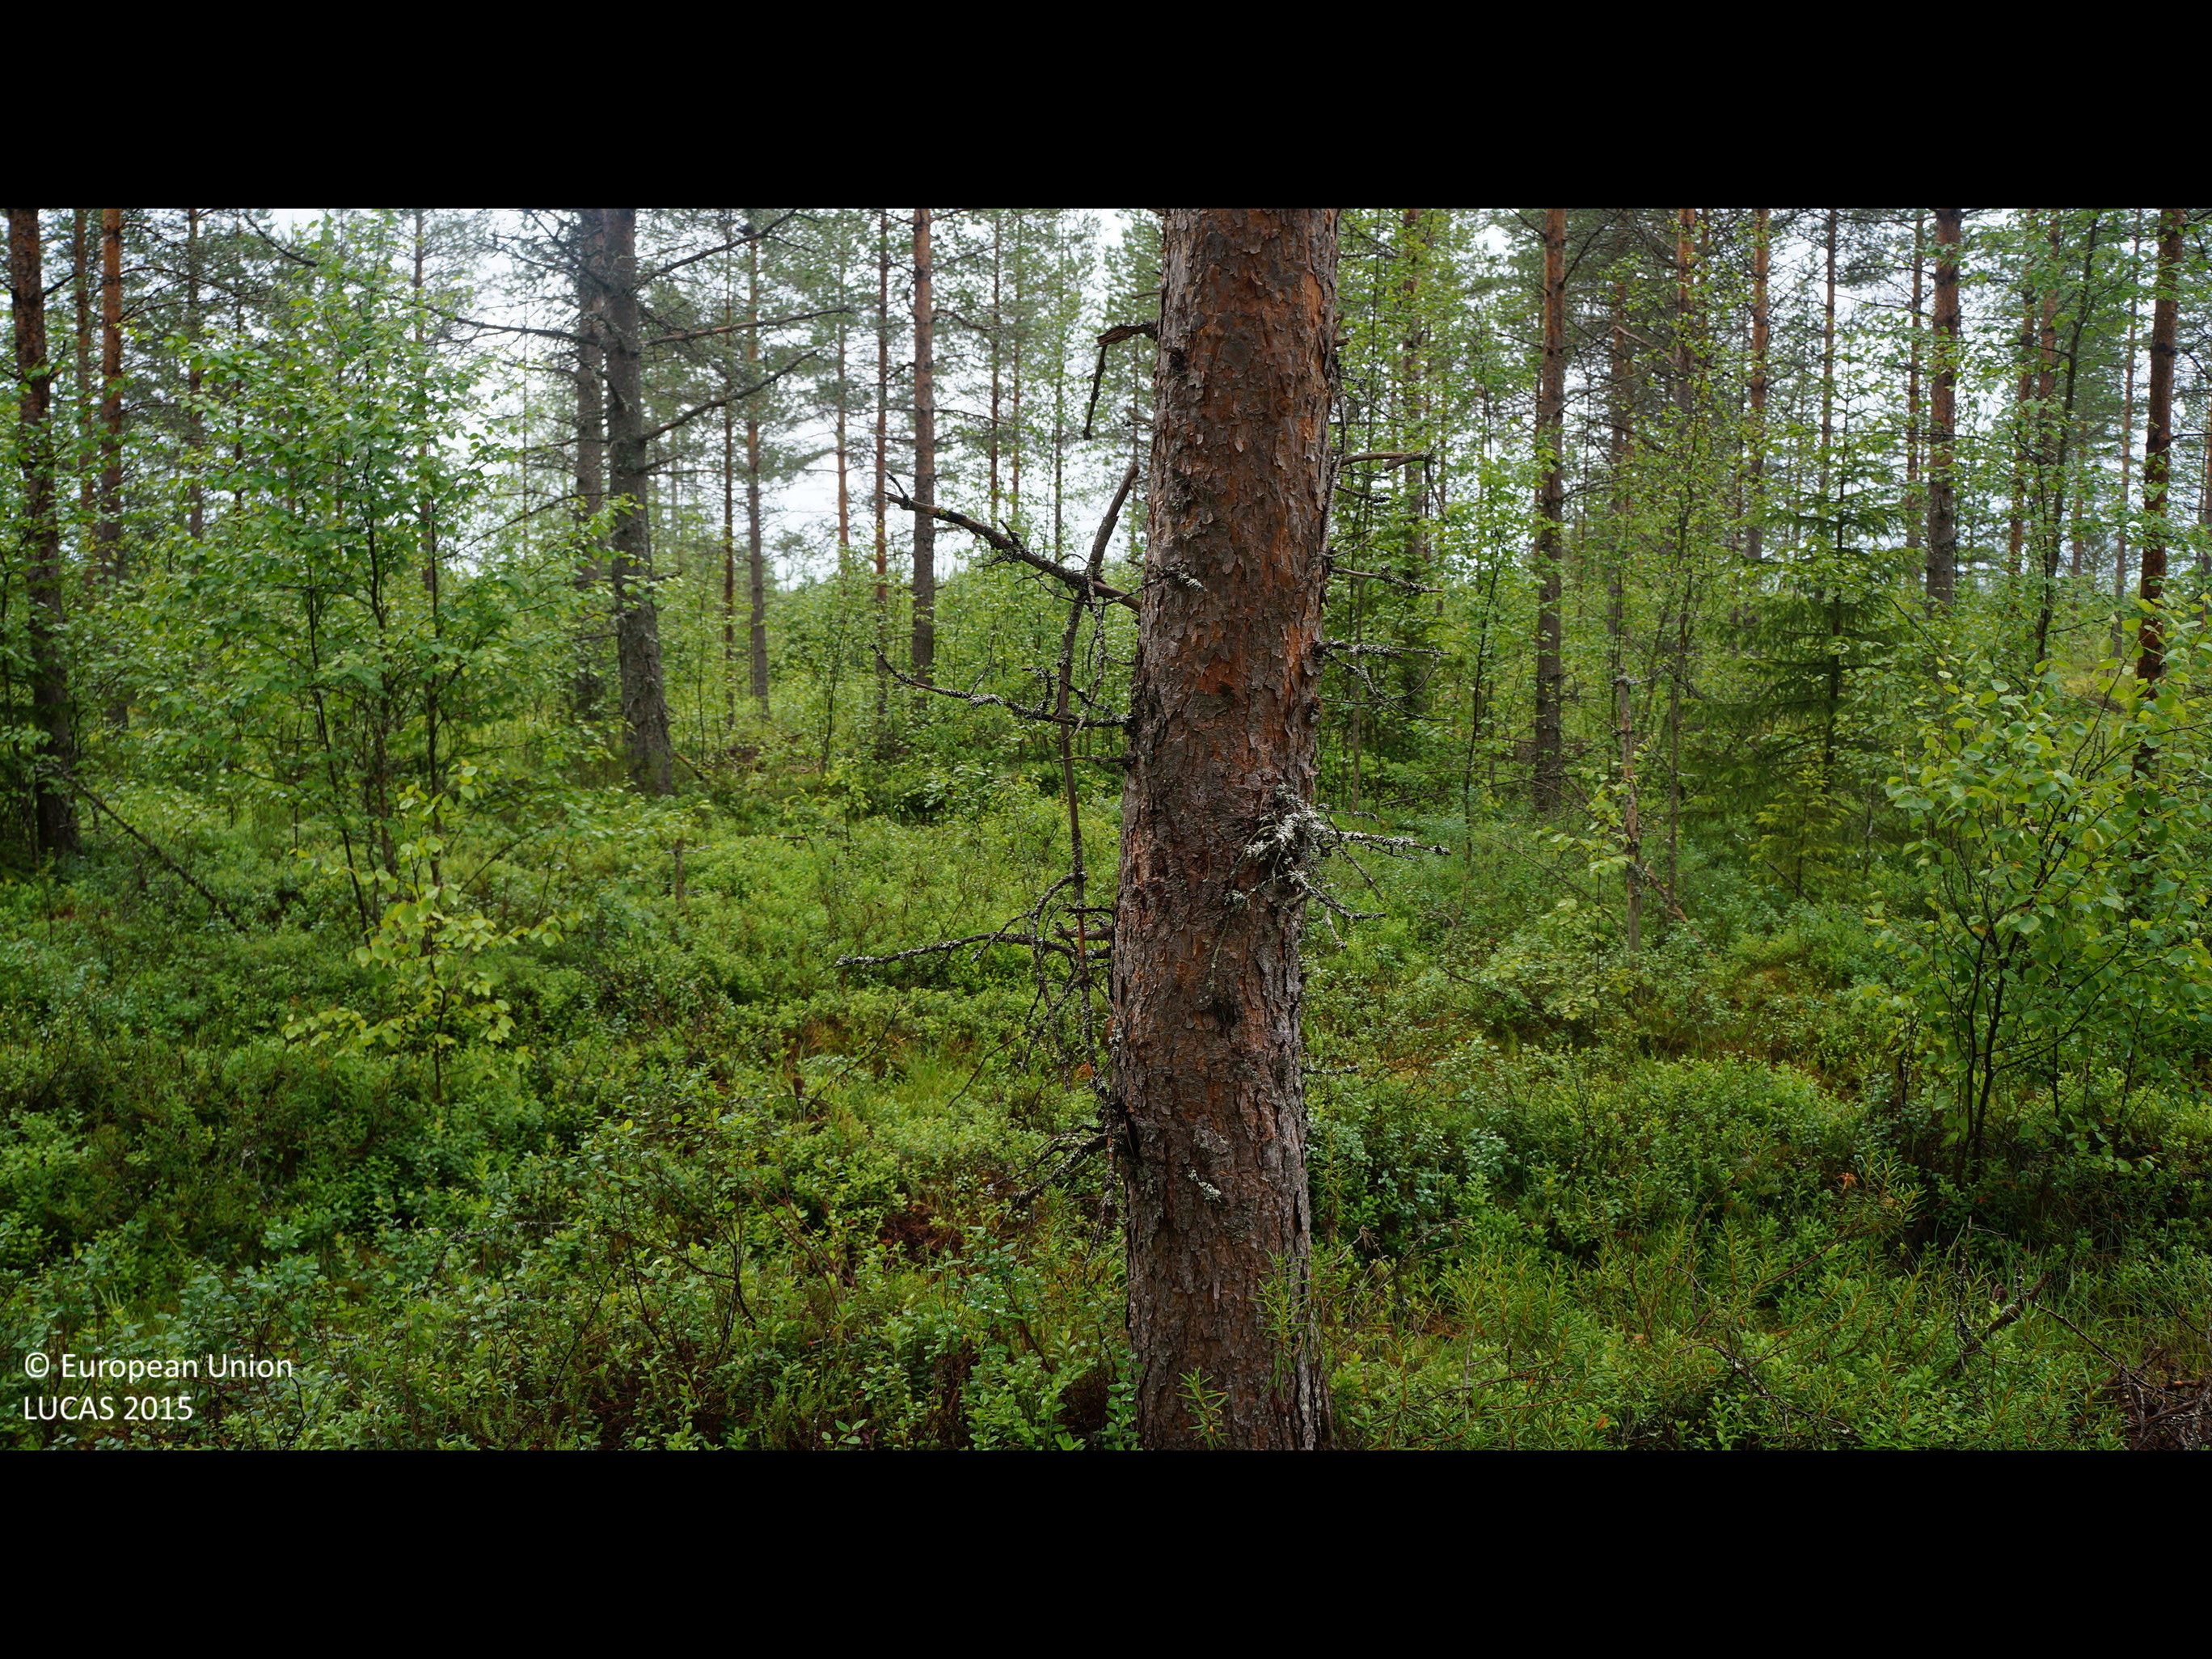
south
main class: Woodland
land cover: Pine dominated coniferous woodland
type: boreal forest
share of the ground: 50 - 75 %
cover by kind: coniferous forest trees 55 %, shrubs 40 %, broadleaved forest trees 5 %
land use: Forestry
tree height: > 5 m
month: July
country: FI
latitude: 64.4767
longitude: 24.5689
